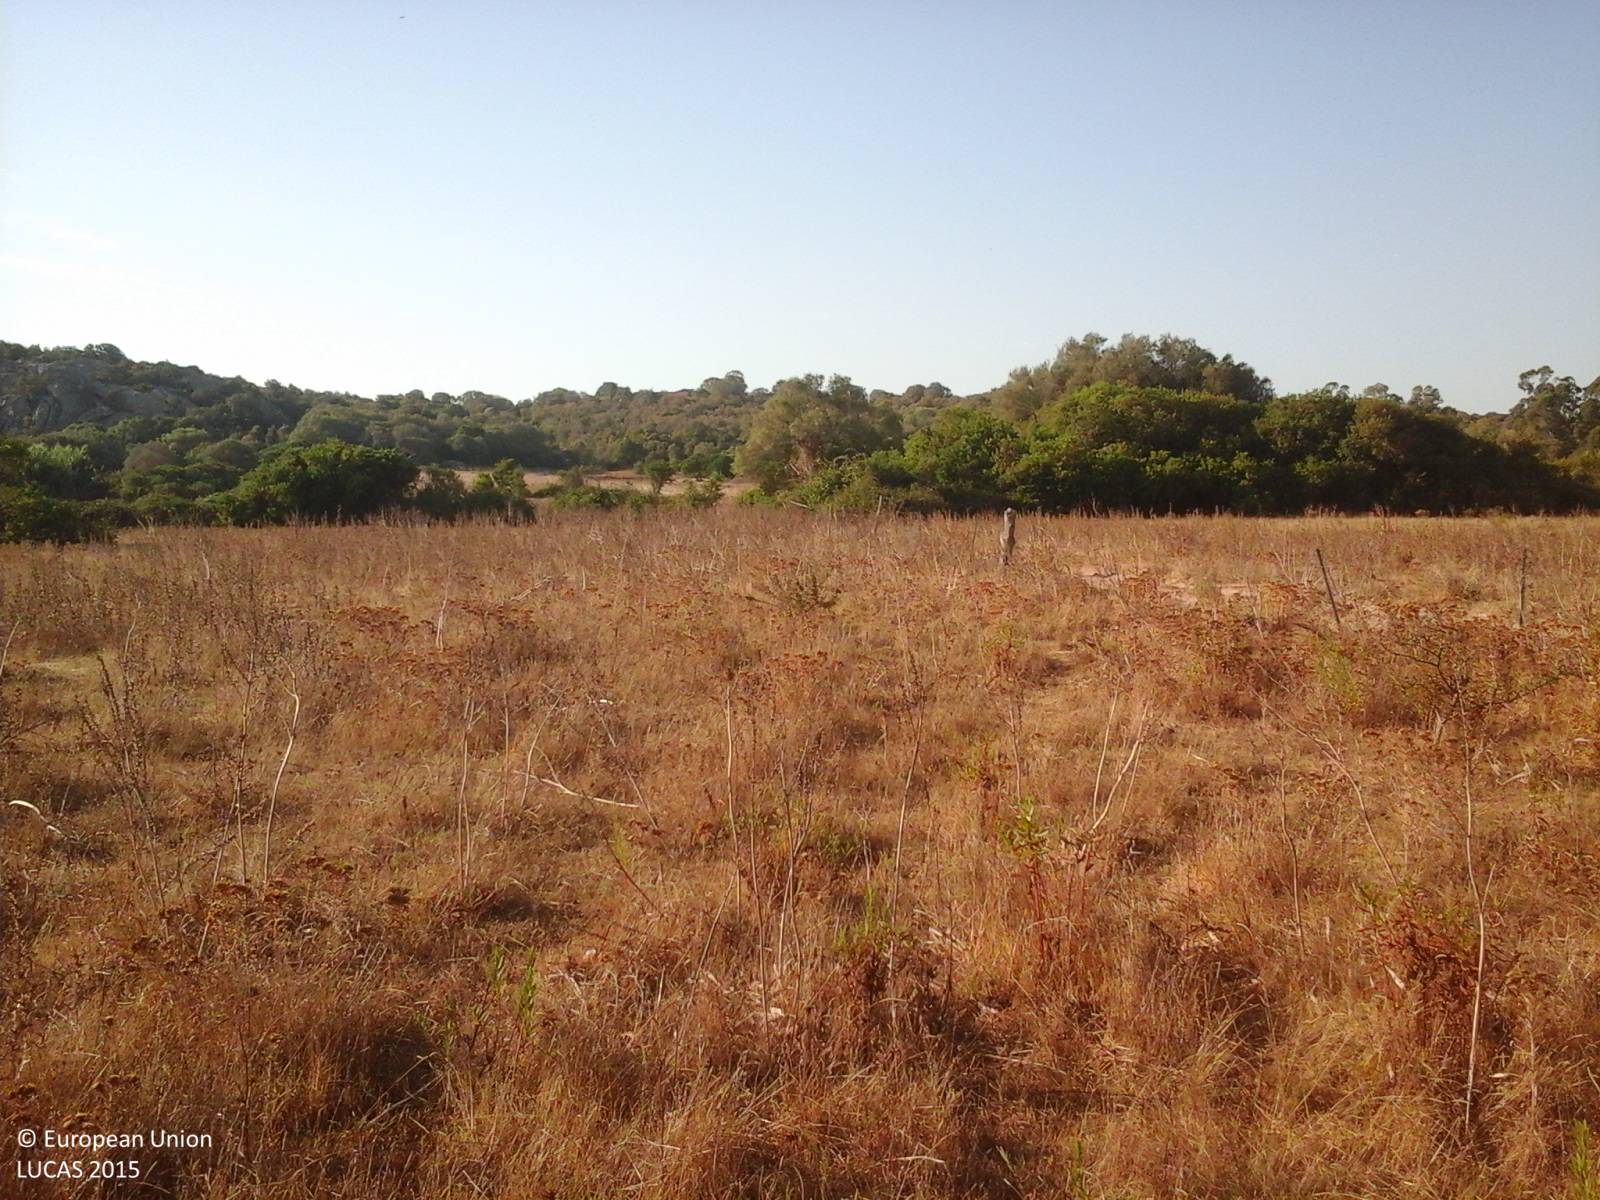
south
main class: Grassland
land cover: Grassland without tree/shrub cover
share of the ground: > 75 %
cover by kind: herbaceous plants 95 %, shrubs 5 %
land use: Agriculture (excluding fallow land and kitchen gardens)
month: September
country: IT
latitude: 41.0618
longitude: 9.4196
